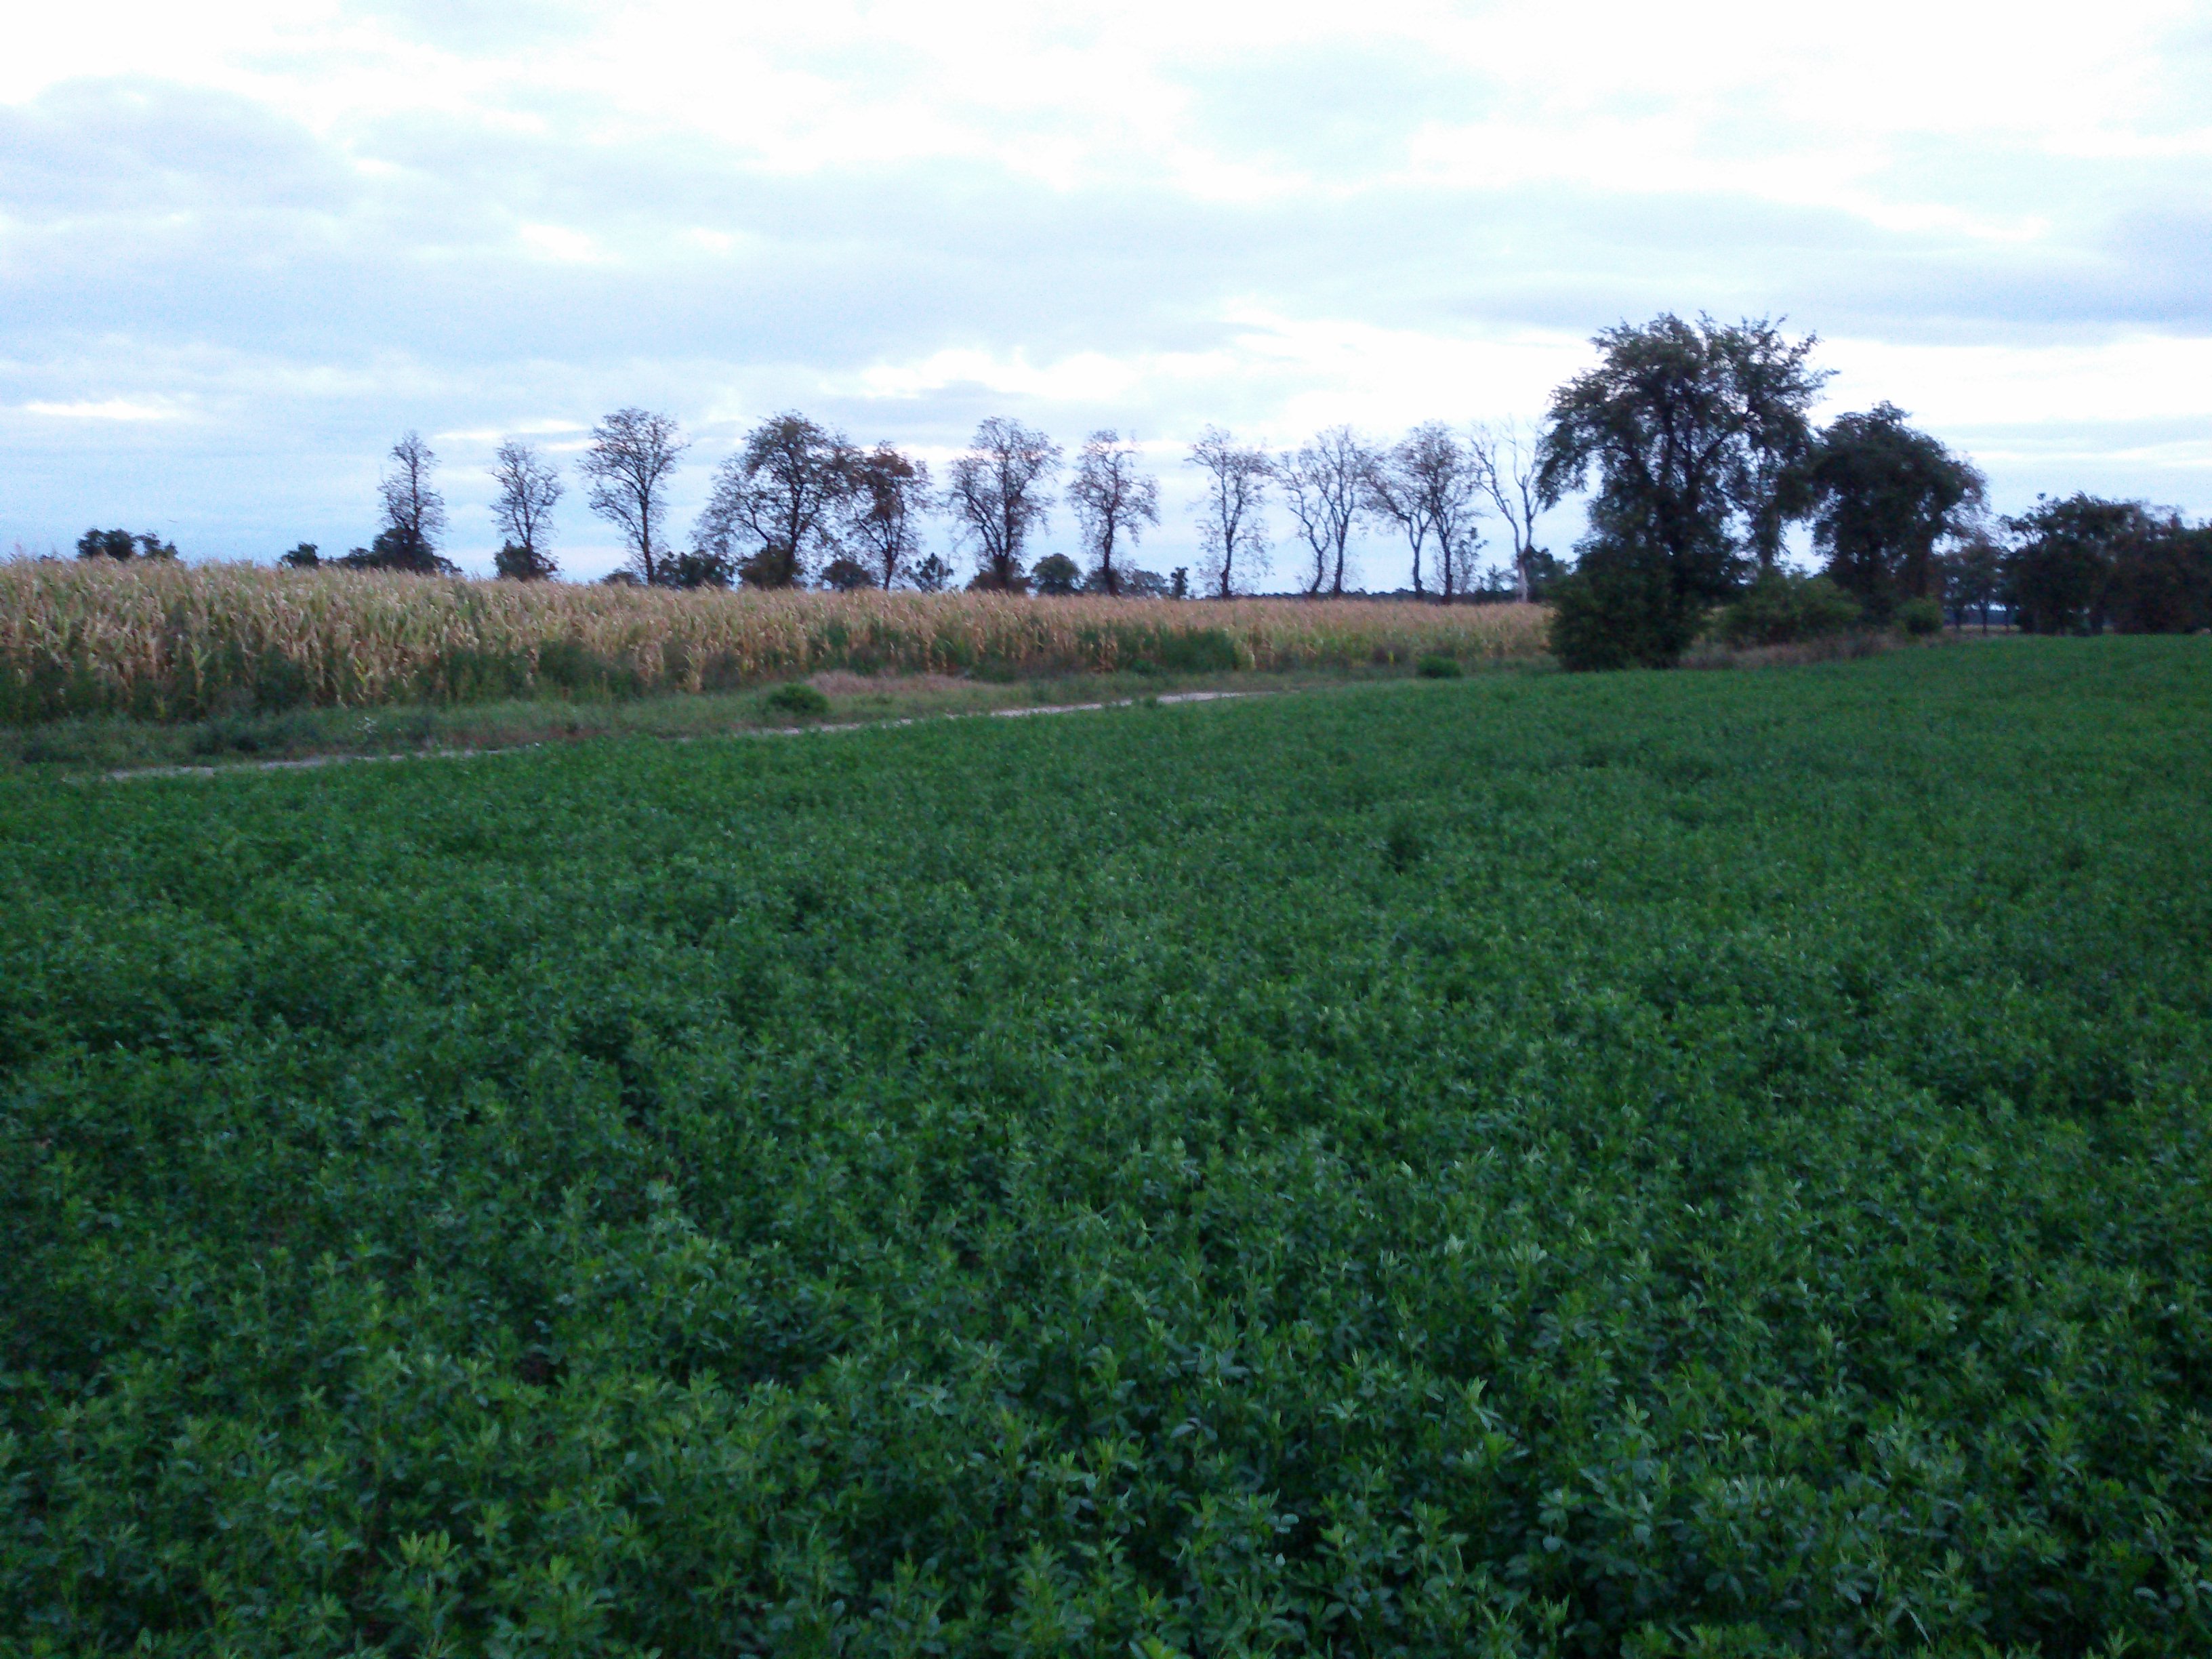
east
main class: Cropland
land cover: Lucerne
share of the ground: > 75 %
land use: Agriculture (excluding fallow land and kitchen gardens)
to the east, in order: Lucerne; Tracks; Grass margins; Maize; Lines of trees; Tracks; Lines of trees; Spontaneously vegetated surfaces; Fences; Potatoes; Other bare soil; Potatoes; Cherry fruit; Other bare soil; Cherry fruit; Other fresh vegetables
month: September
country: PL
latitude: 53.0147
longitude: 17.6597
